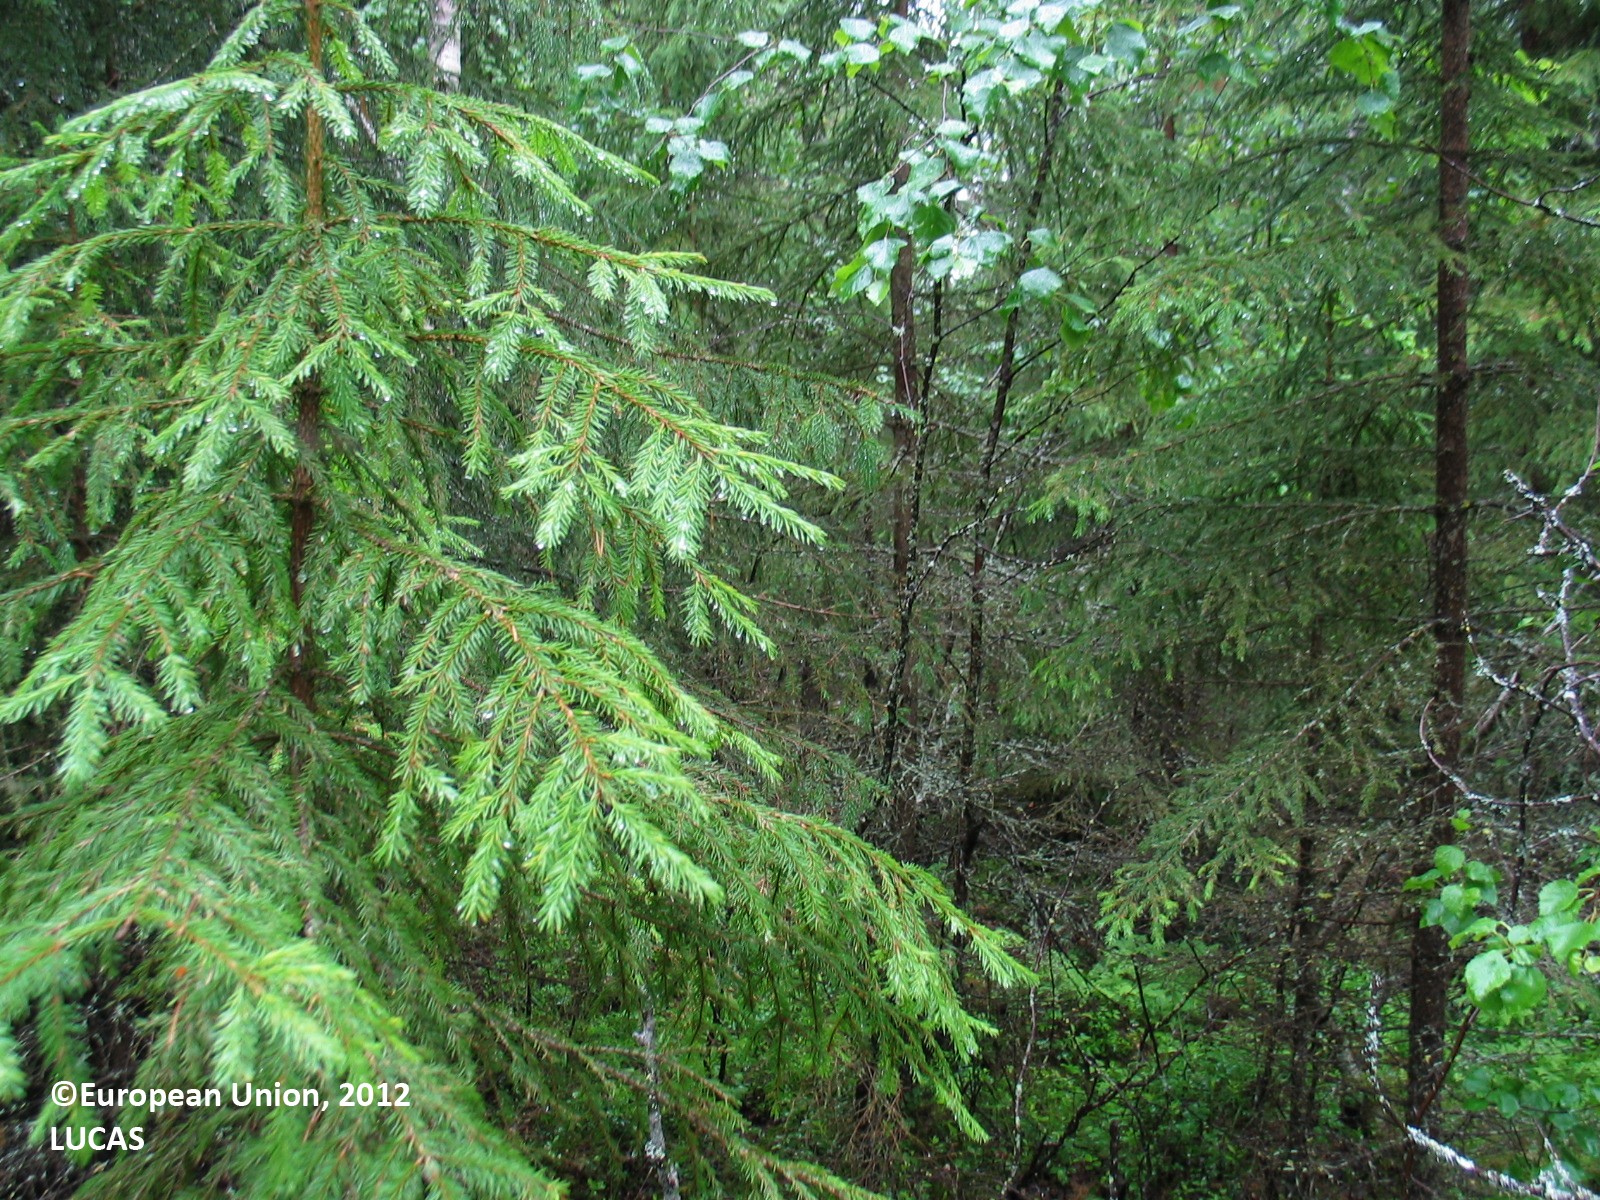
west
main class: Woodland
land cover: Pine dominated coniferous woodland
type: boreal forest
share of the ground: 25 - 50 %
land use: Forestry
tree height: > 5 m
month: July
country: FI
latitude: 66.0384
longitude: 24.8639
